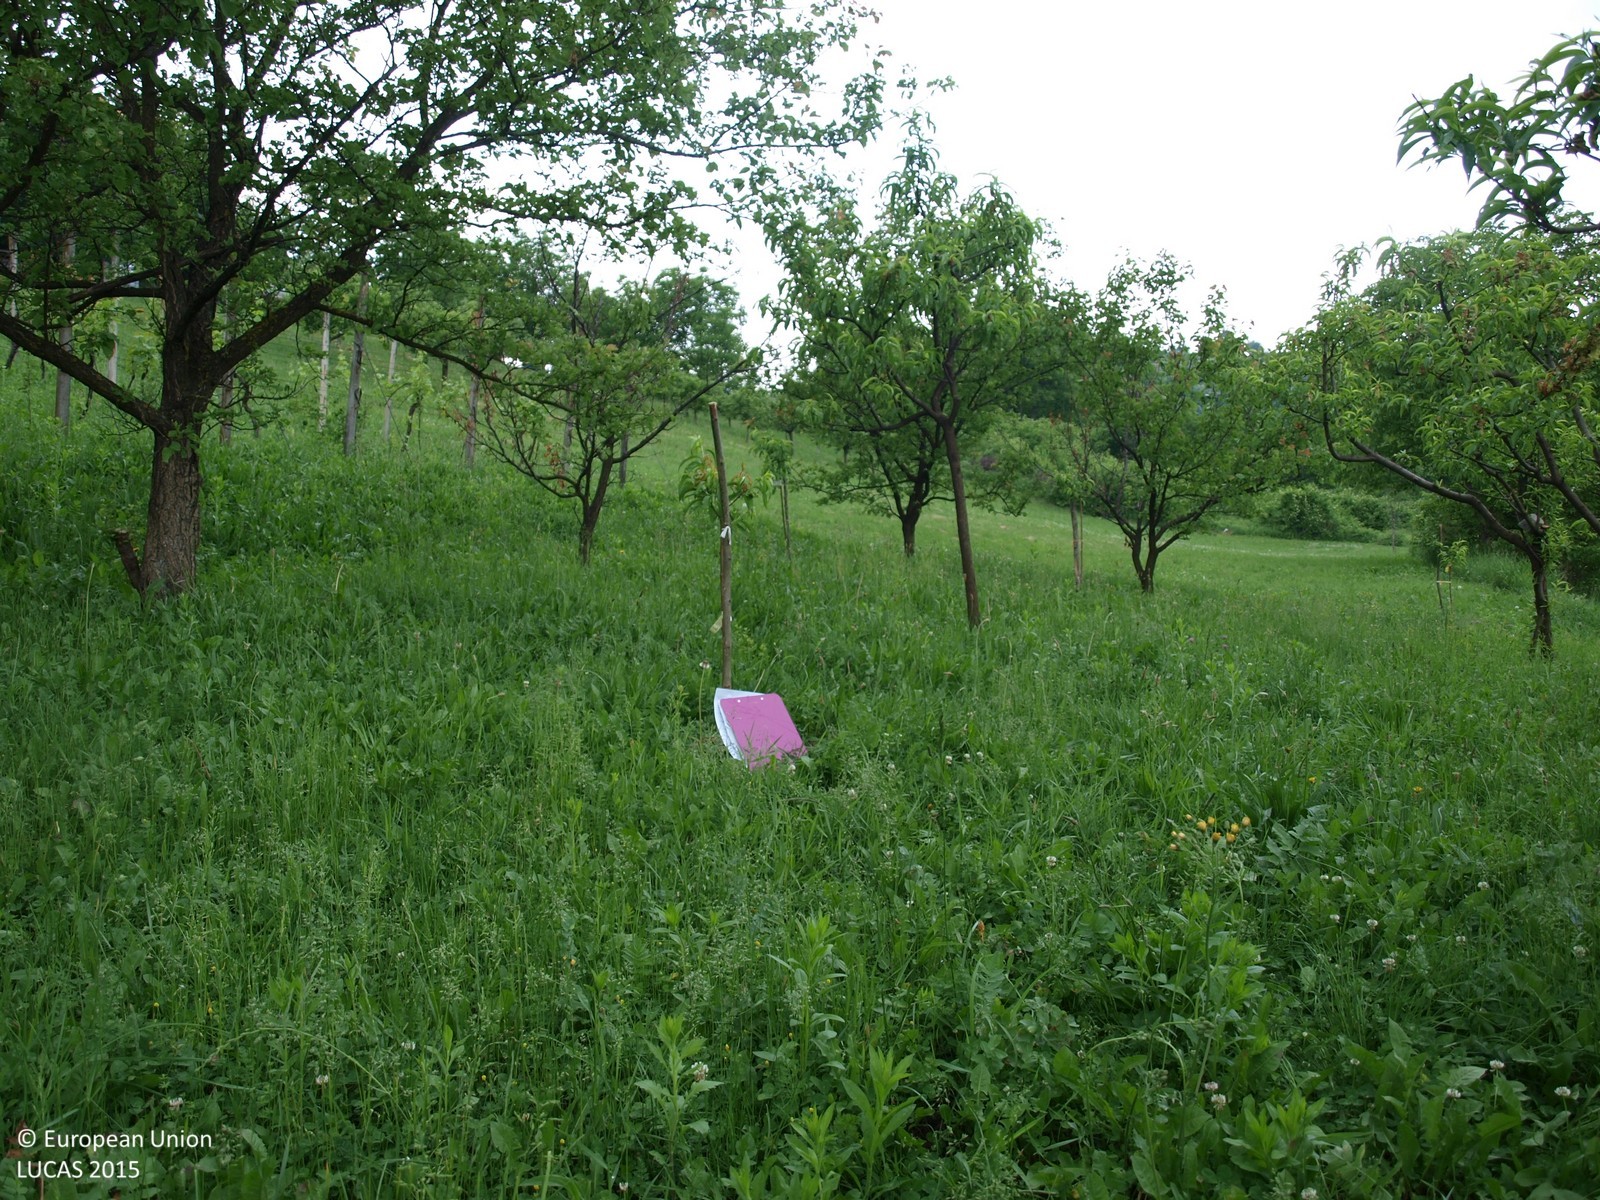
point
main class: Cropland
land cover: Other fruit trees and berries
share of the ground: 25 - 50 %
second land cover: Grassland without tree/shrub cover
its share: > 75 %
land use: Kitchen garden
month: May
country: HR
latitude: 46.1128
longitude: 16.2747
